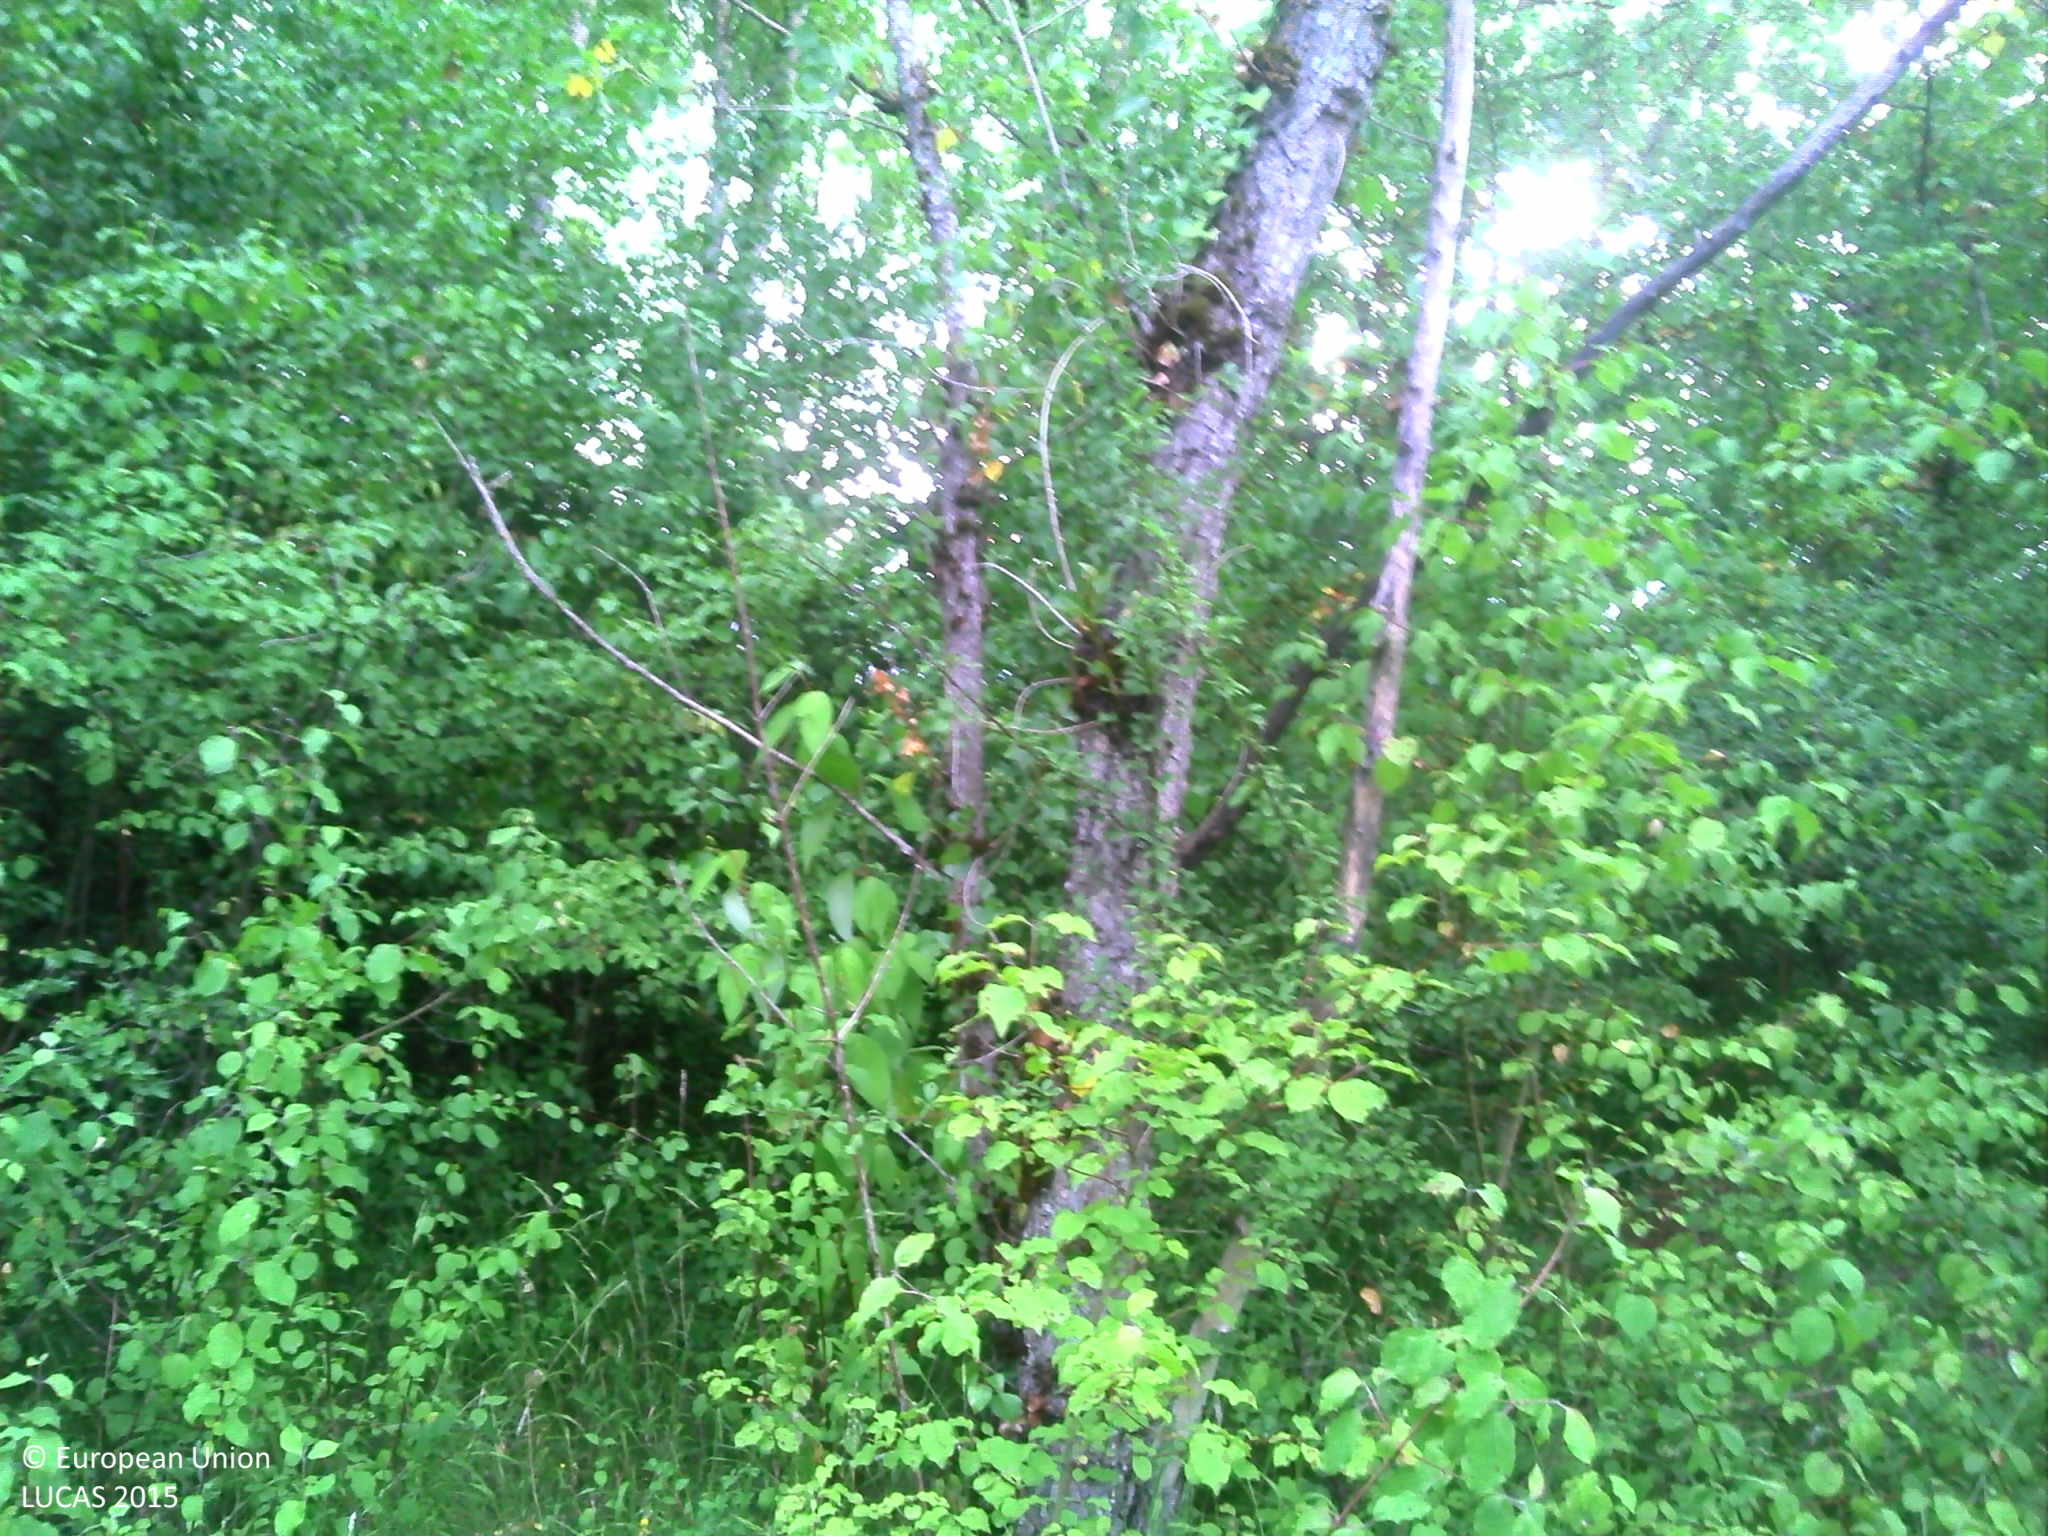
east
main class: Woodland
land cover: Broadleaved woodland
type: beech forest
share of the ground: > 75 %
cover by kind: broadleaved forest trees 60 %, herbaceous plants 30 %, lichens and mosses 10 %
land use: Semi-natural and natural areas not in use
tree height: > 5 m
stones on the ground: < 10 %
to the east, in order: Broadleaved woodland; Grassland without tree/shrub cover; Fences; Grassland without tree/shrub cover; Fences; Paved roads, cycling and walking lanes; Spontaneously vegetated surfaces; Fences; Common wheat; Maize
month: July
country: FR
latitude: 46.1435
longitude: 6.3140
